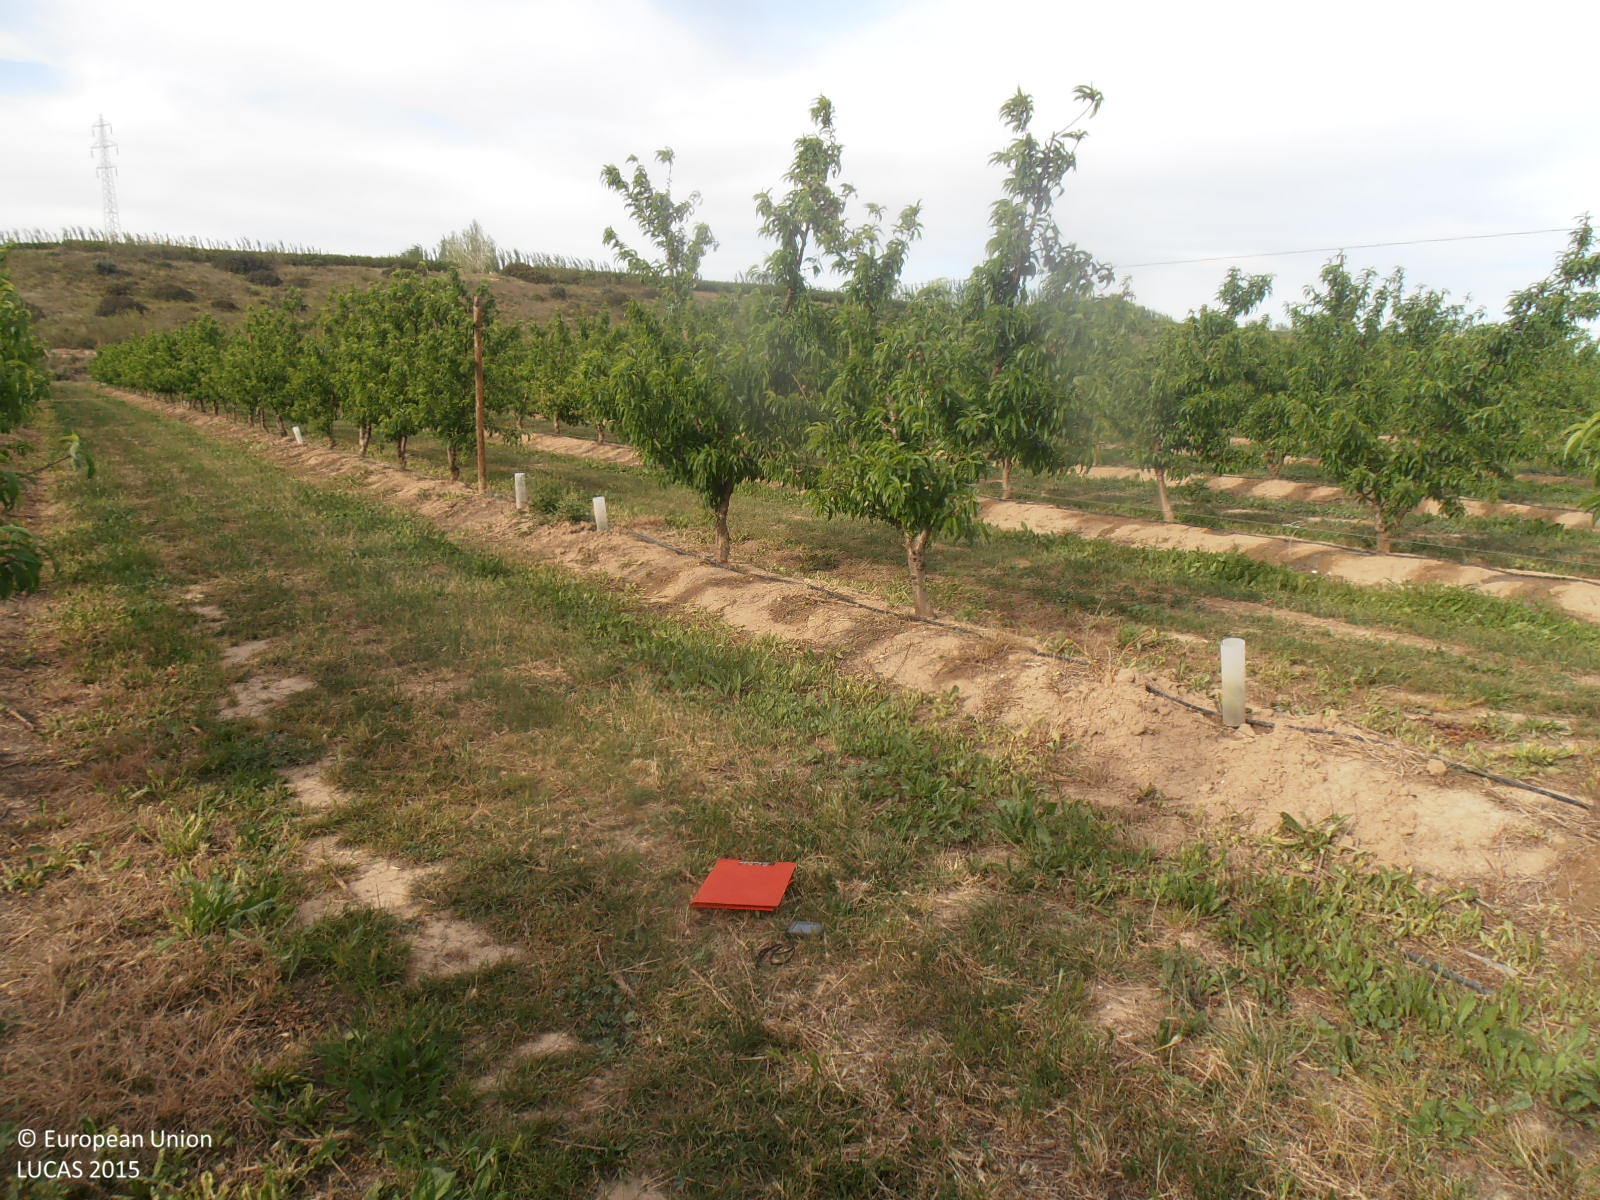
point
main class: Cropland
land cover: Other fruit trees and berries
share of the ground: 50 - 75 %
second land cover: Grassland without tree/shrub cover
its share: > 75 %
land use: Agriculture (excluding fallow land and kitchen gardens)
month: April
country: ES
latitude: 41.2810
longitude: -0.3903
